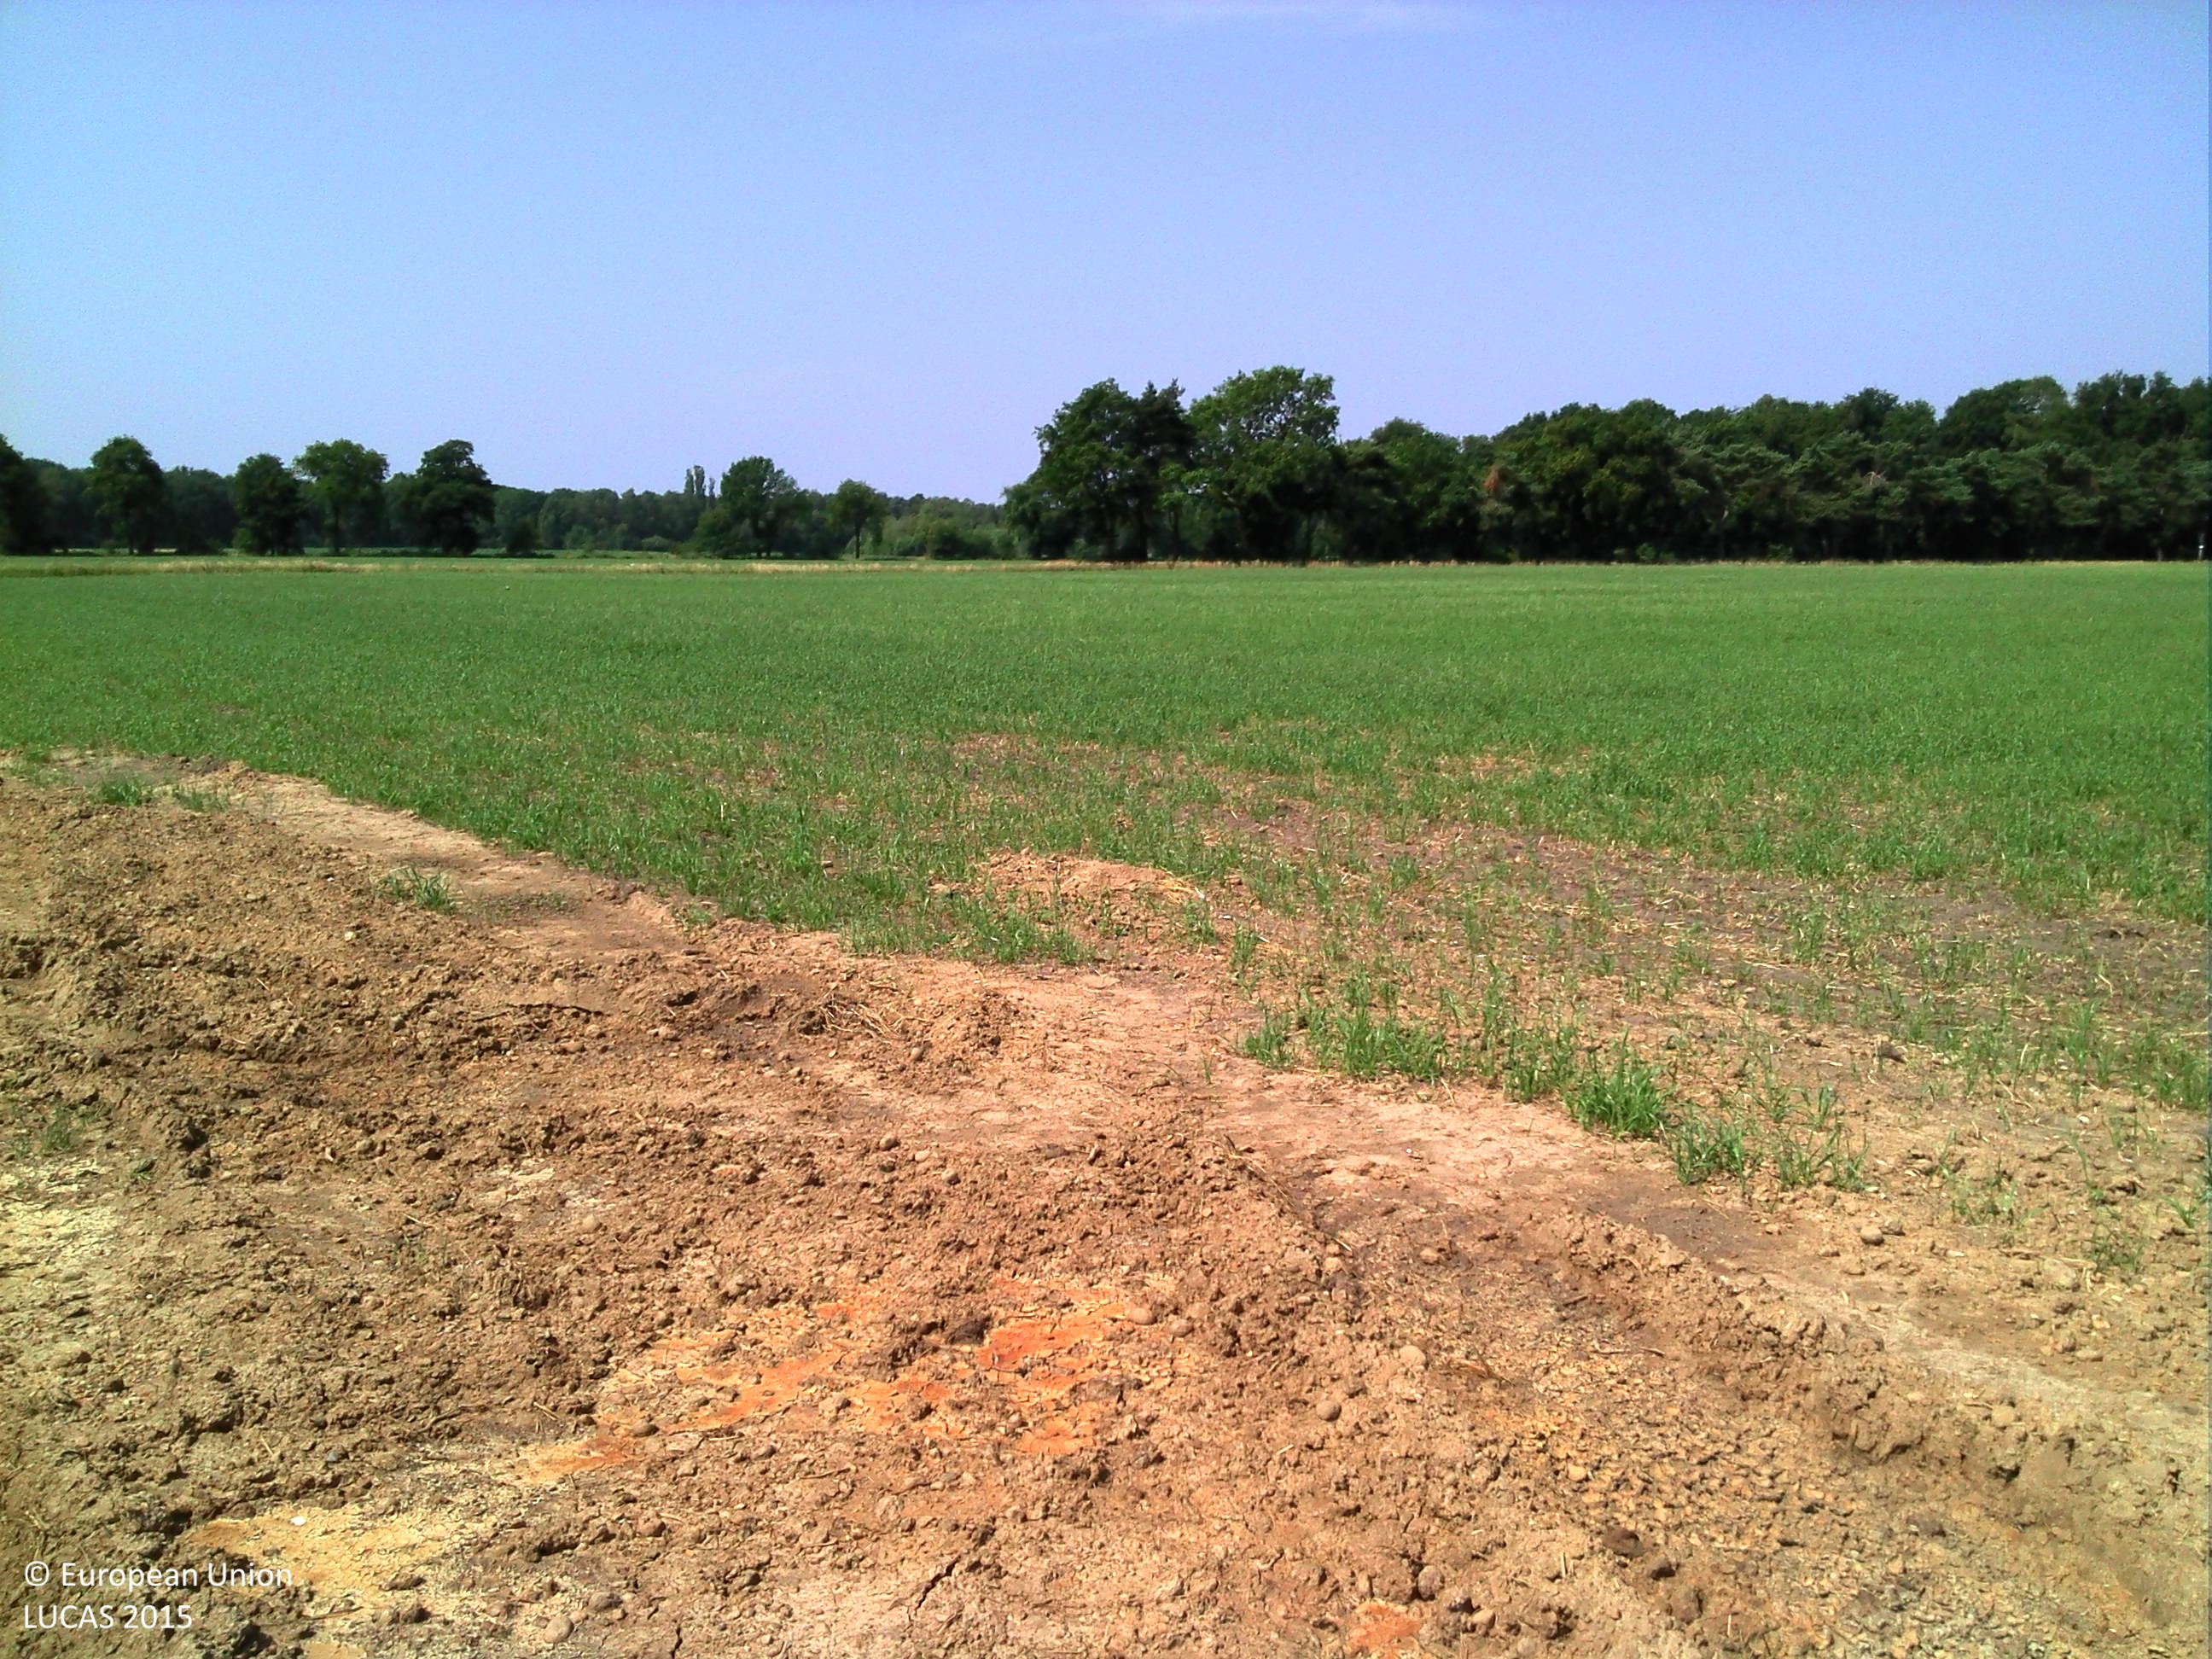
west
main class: Cropland
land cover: Maize
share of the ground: > 75 %
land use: Agriculture (excluding fallow land and kitchen gardens)
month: July
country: BE
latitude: 51.0826
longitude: 5.4157
